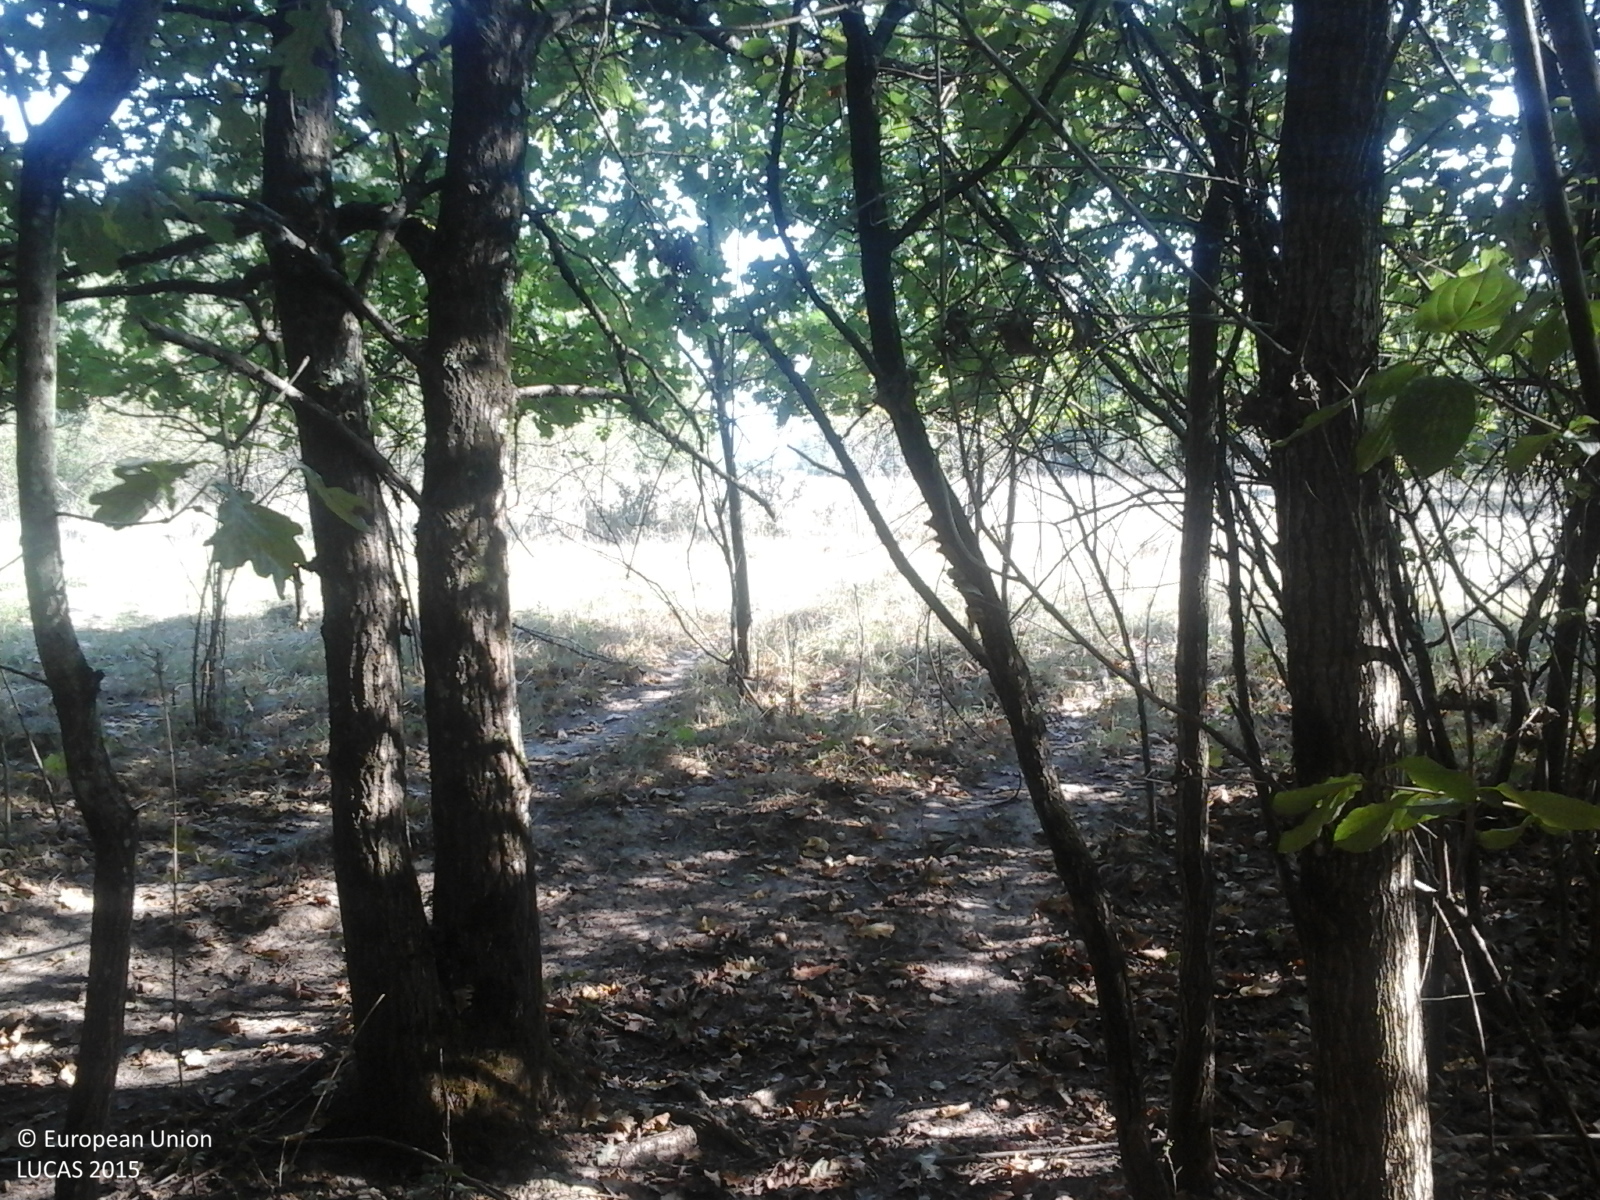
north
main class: Woodland
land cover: Broadleaved woodland
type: acidophilous oak and oak-birch forest
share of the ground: > 75 %
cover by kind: broadleaved forest trees 100 %
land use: Forestry
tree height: > 5 m
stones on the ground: < 10 %
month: August
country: RO
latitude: 46.4133
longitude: 22.2108
